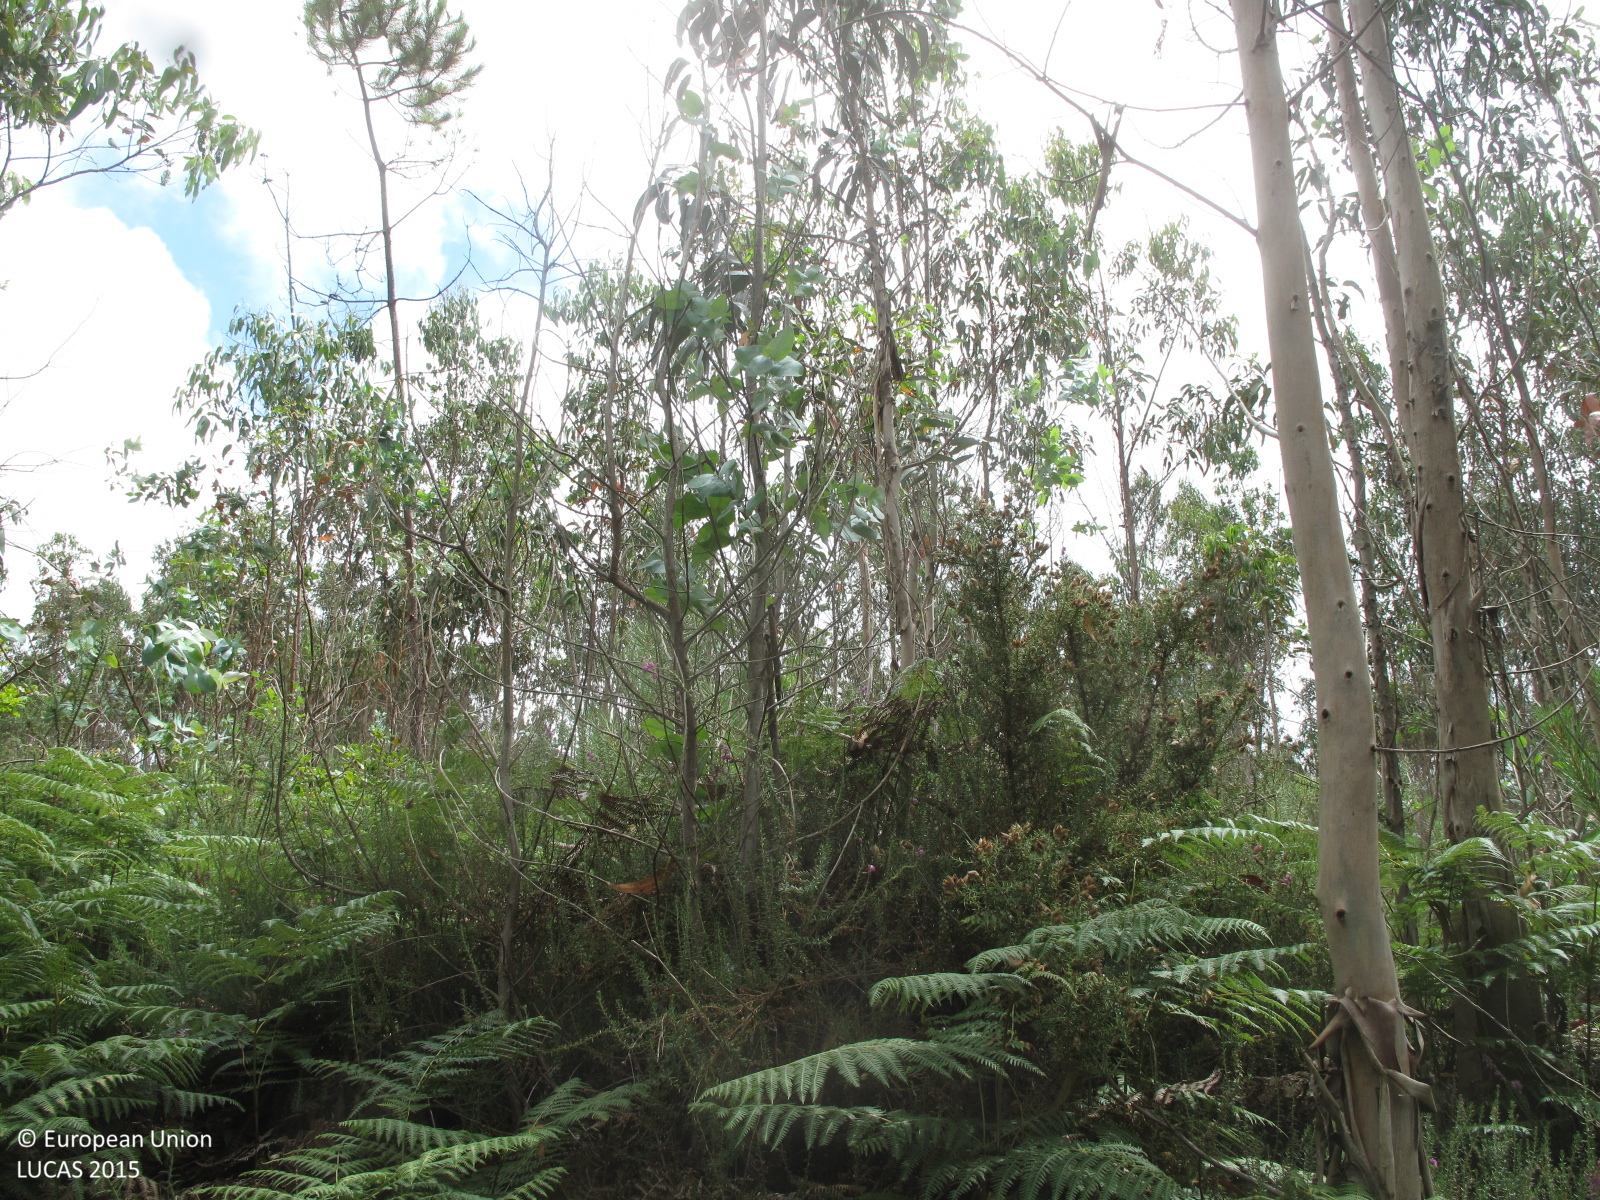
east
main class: Woodland
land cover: Broadleaved woodland
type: exotic forest
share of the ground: 25 - 50 %
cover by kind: broadleaved forest trees 45 %, herbaceous plants 30 %, shrubs 20 %, coniferous forest trees 5 %
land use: Forestry
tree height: > 5 m
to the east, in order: Broadleaved woodland; Pine dominated mixed woodland; Grassland without tree/shrub cover; Tracks; Dry stone walls; Grassland without tree/shrub cover; Dry stone walls; Other mixed woodland
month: July
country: ES
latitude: 43.0161
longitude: -9.2081
